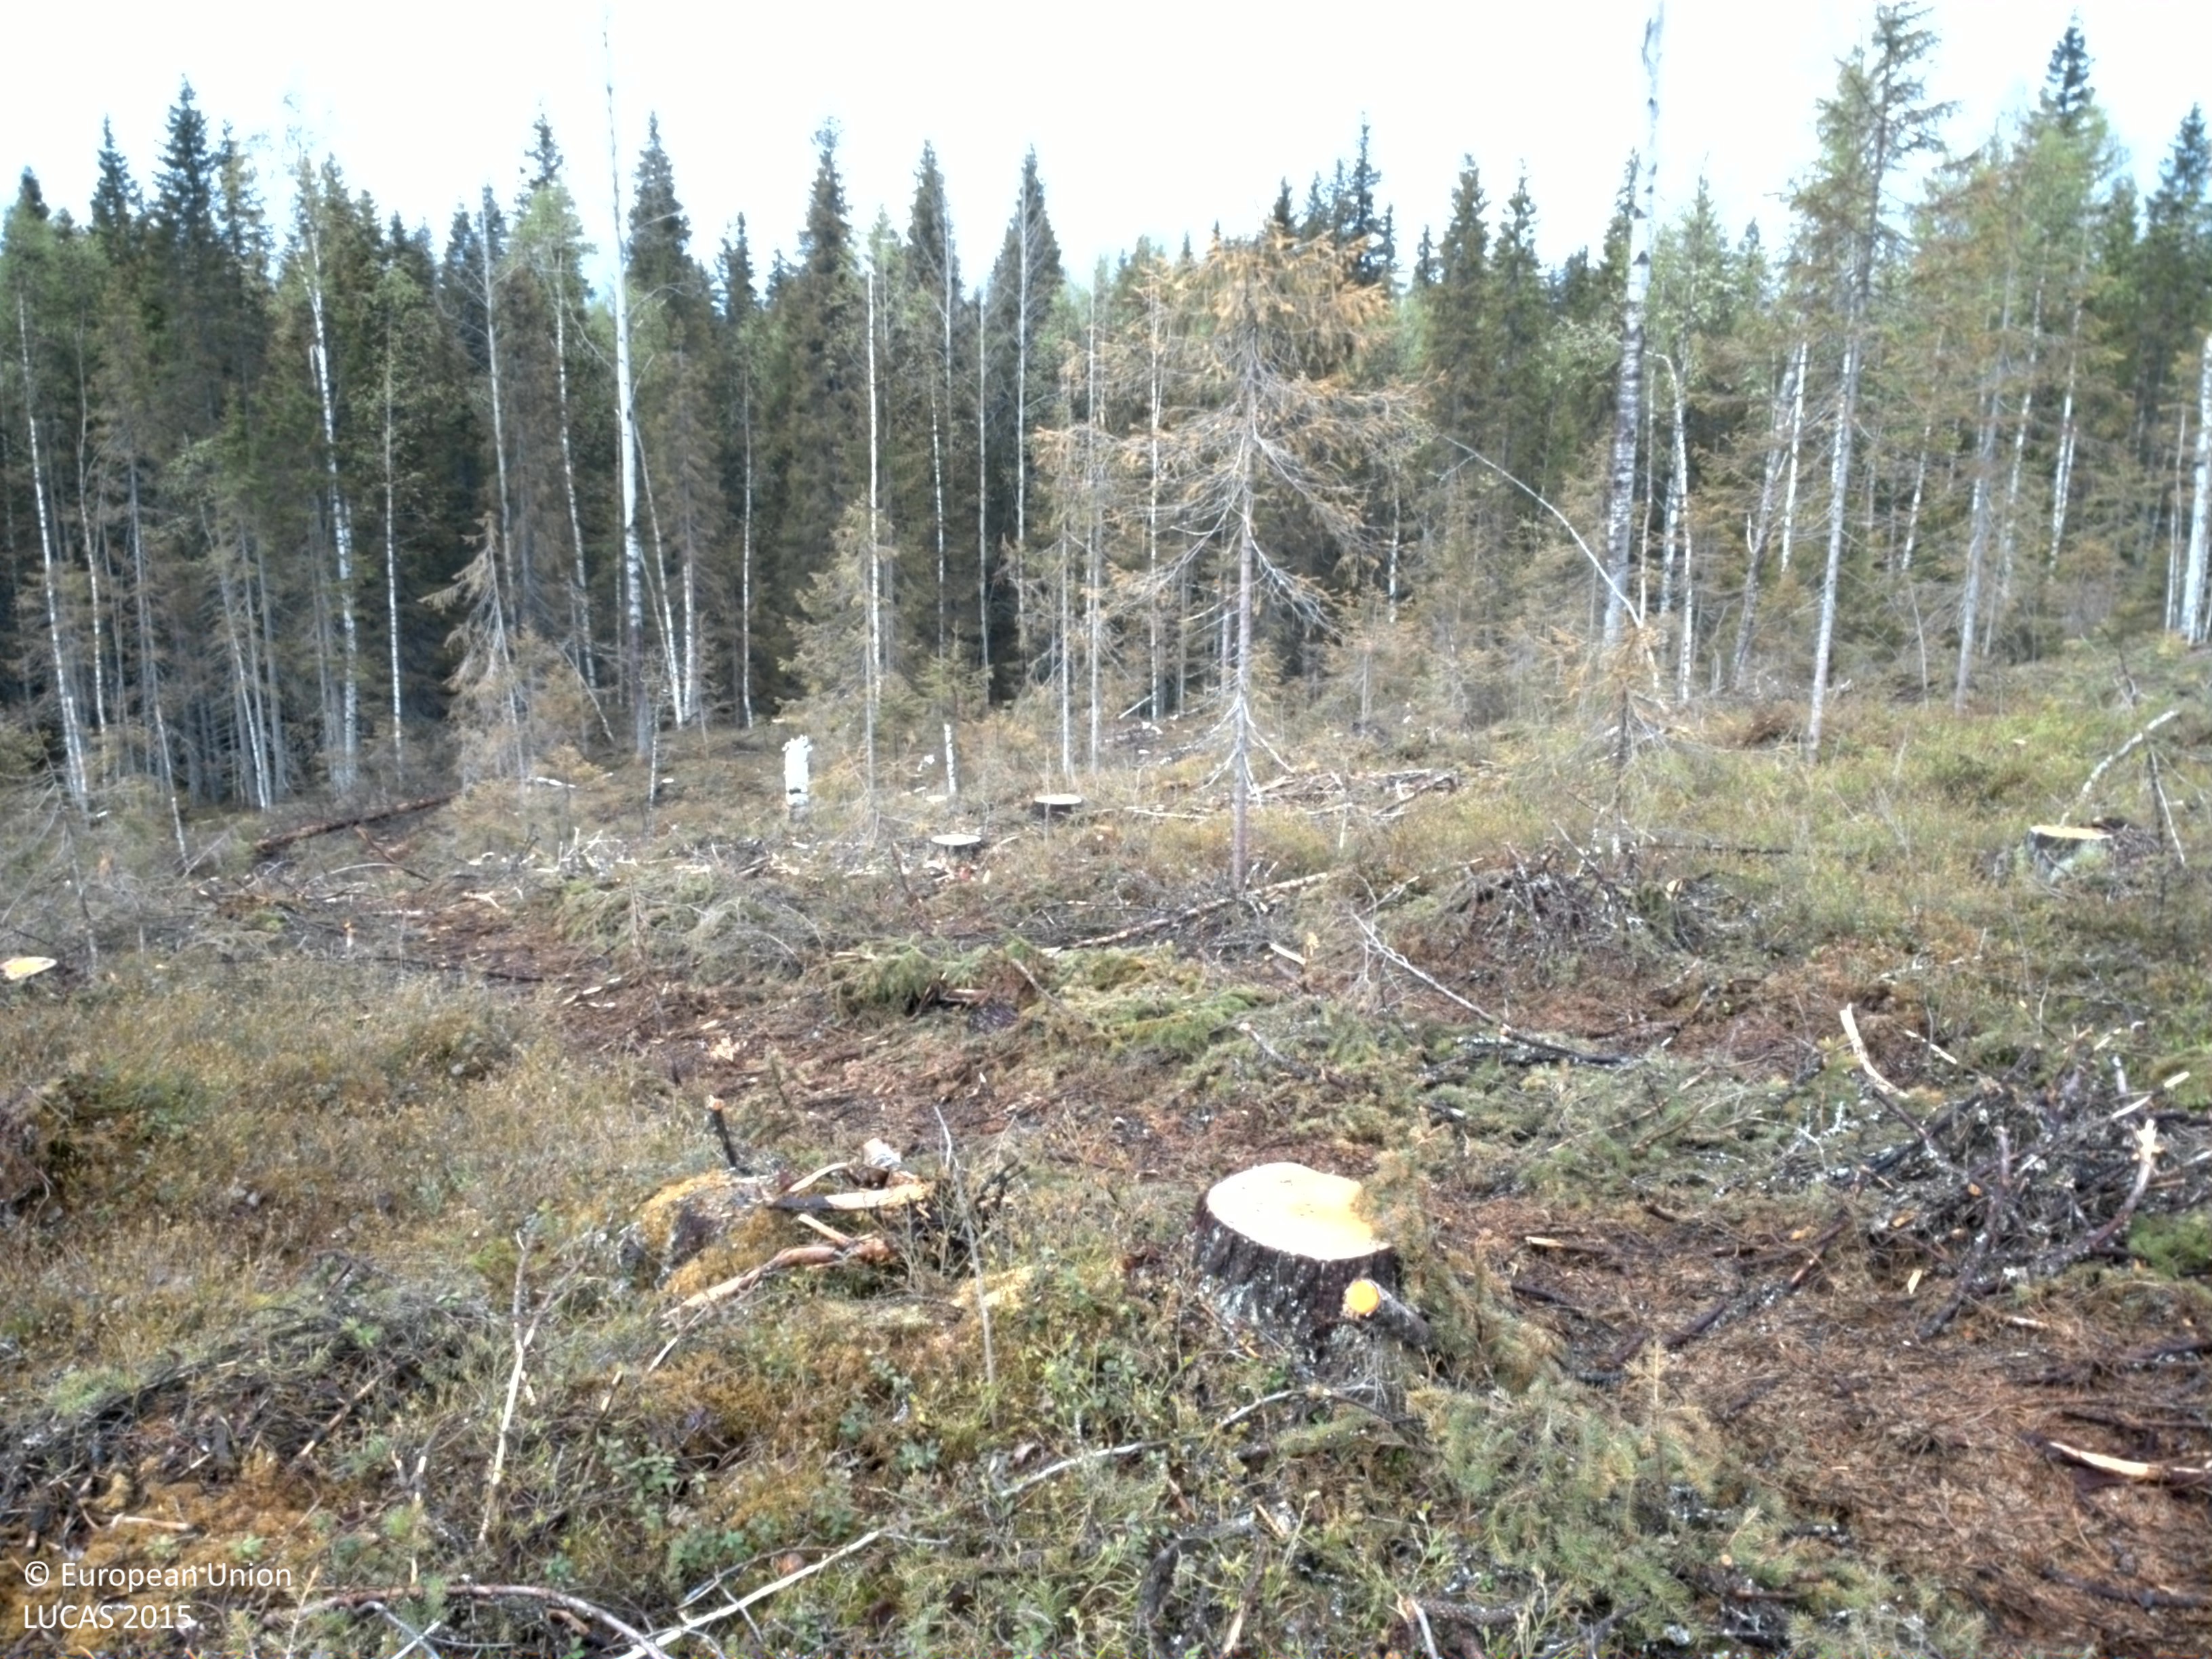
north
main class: Woodland
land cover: Spruce dominated mixed woodland
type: boreal forest
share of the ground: 10 - 25 %
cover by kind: shrubs 75 %, coniferous forest trees 10 %, unconsolidated bare surface 10 %, broadleaved forest trees 5 %
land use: Forestry
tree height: > 5 m
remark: Clear cut
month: May
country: SE
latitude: 66.0483
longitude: 22.9856
